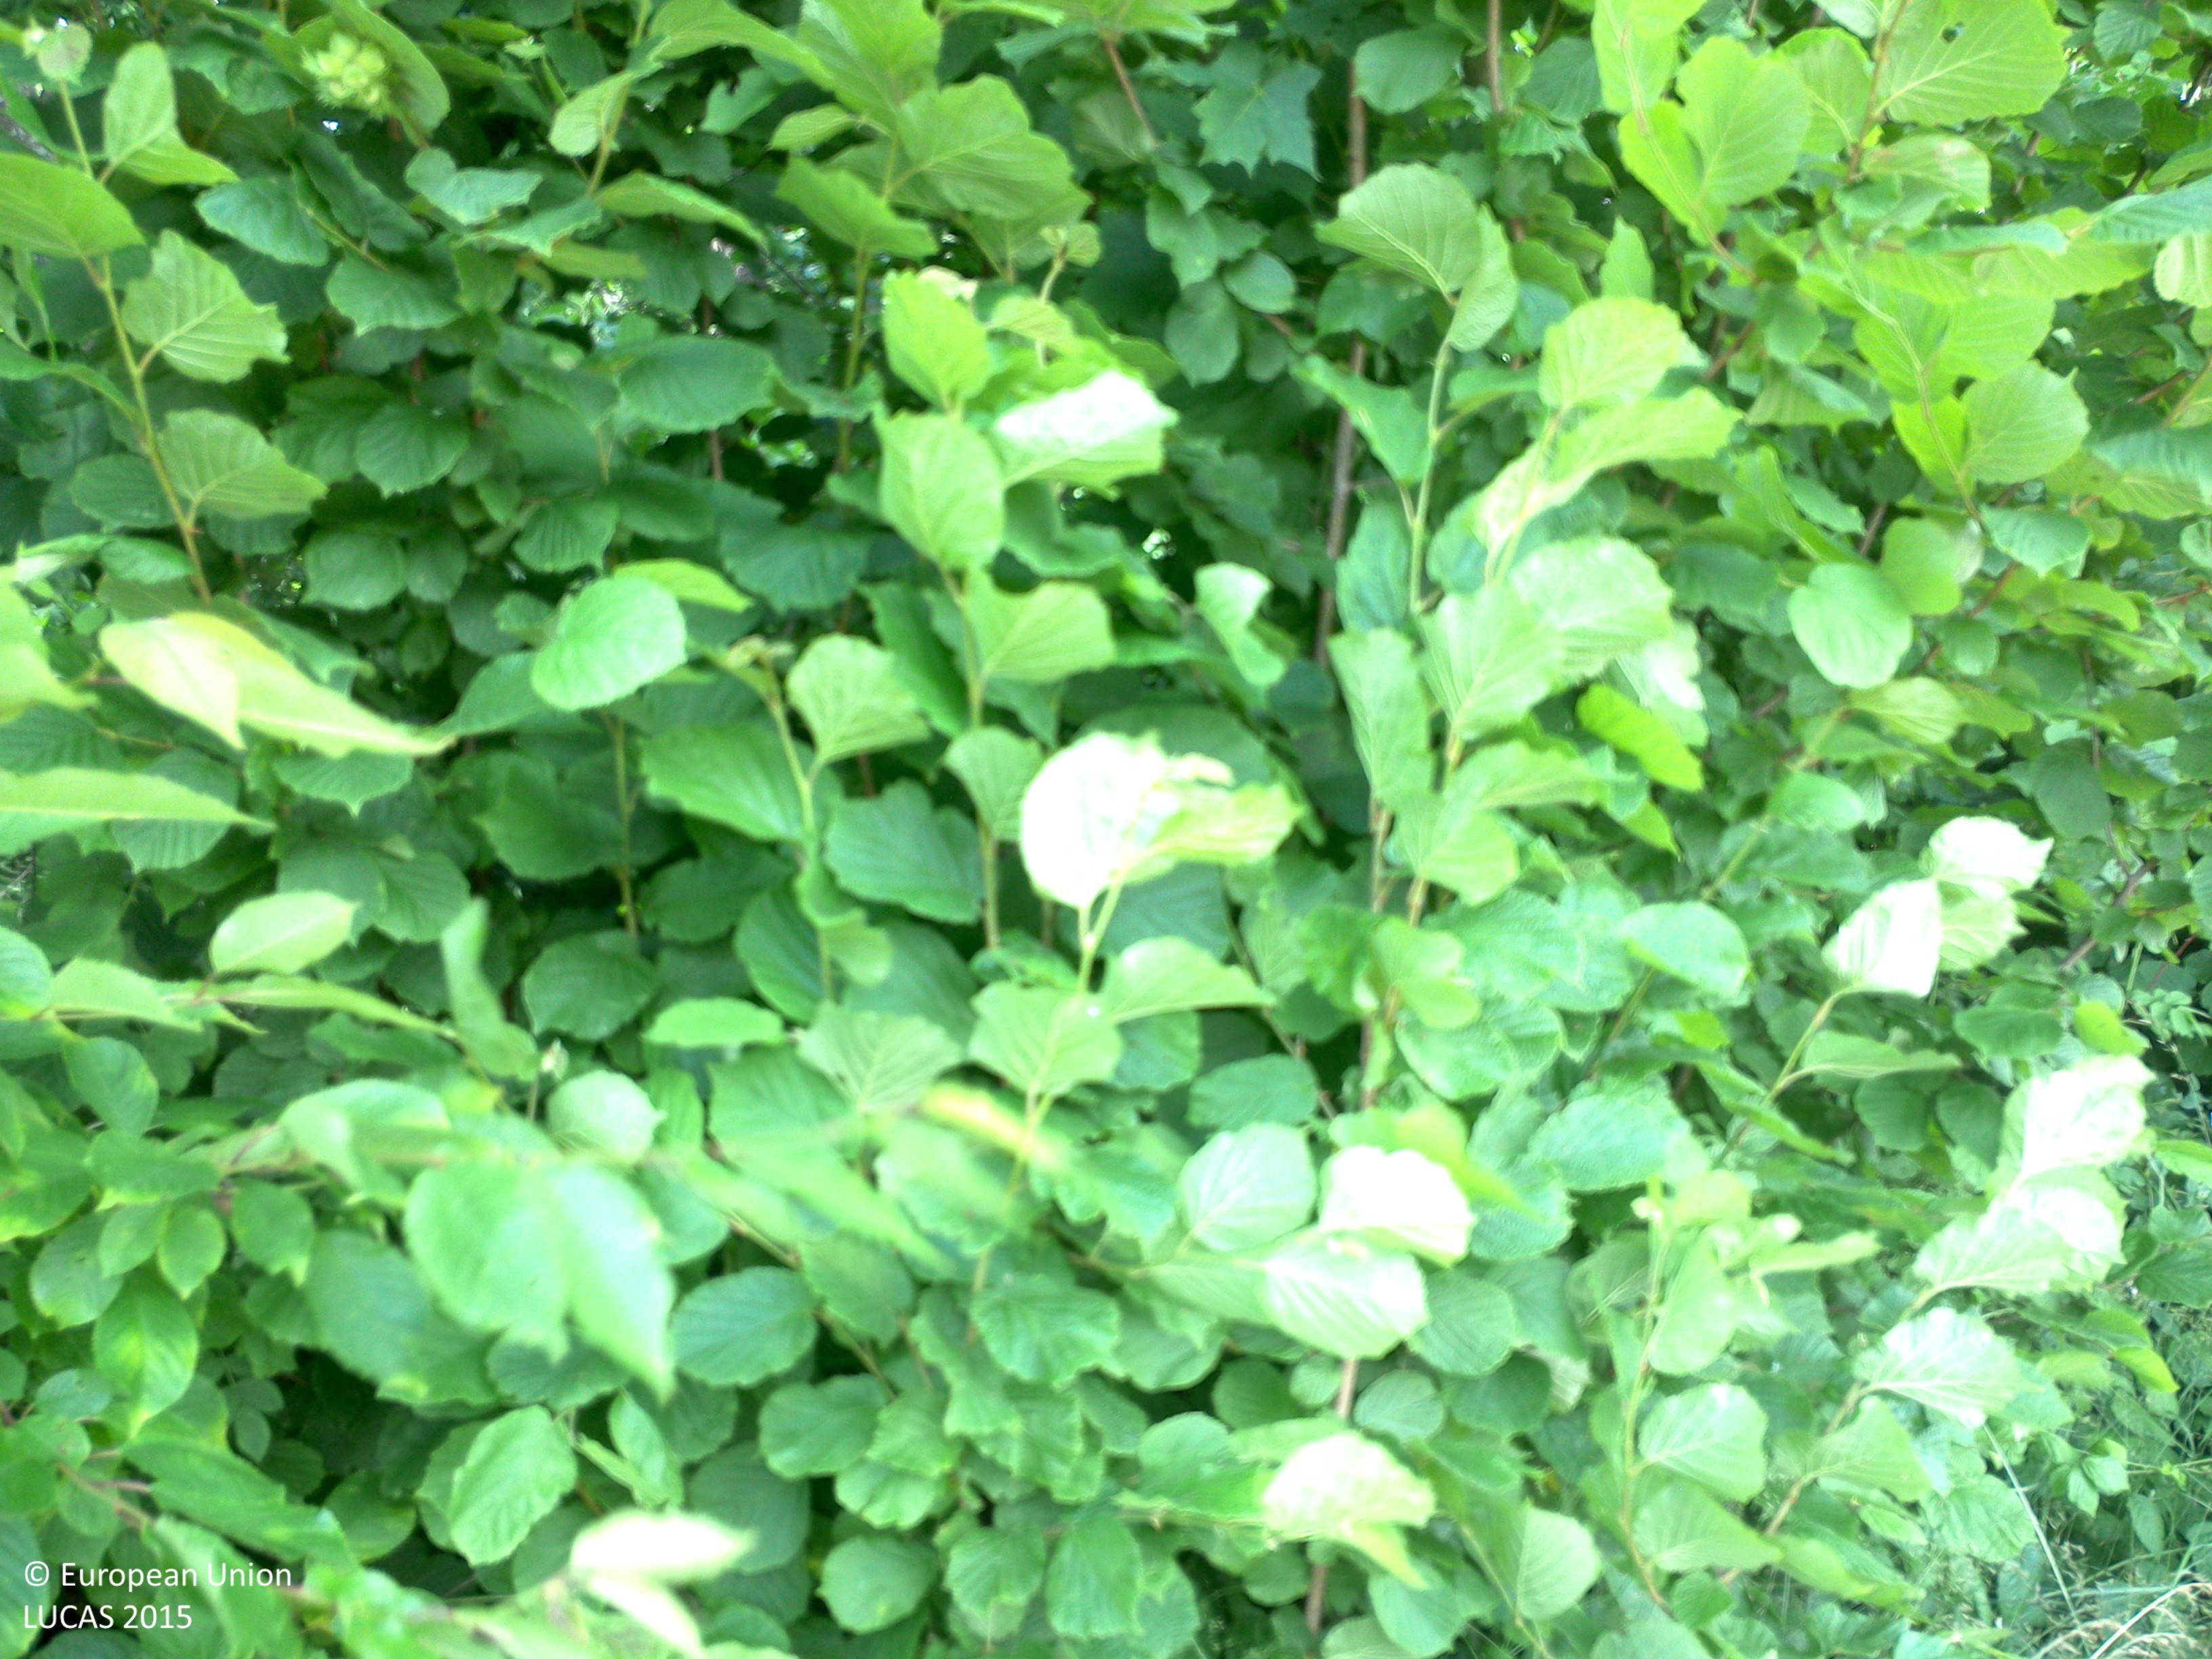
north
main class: Woodland
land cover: Broadleaved woodland
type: boreal forest
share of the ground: > 75 %
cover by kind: broadleaved forest trees 85 %, herbaceous plants 15 %
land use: Forestry
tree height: > 5 m
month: July
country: SE
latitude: 58.5376
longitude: 15.0954
